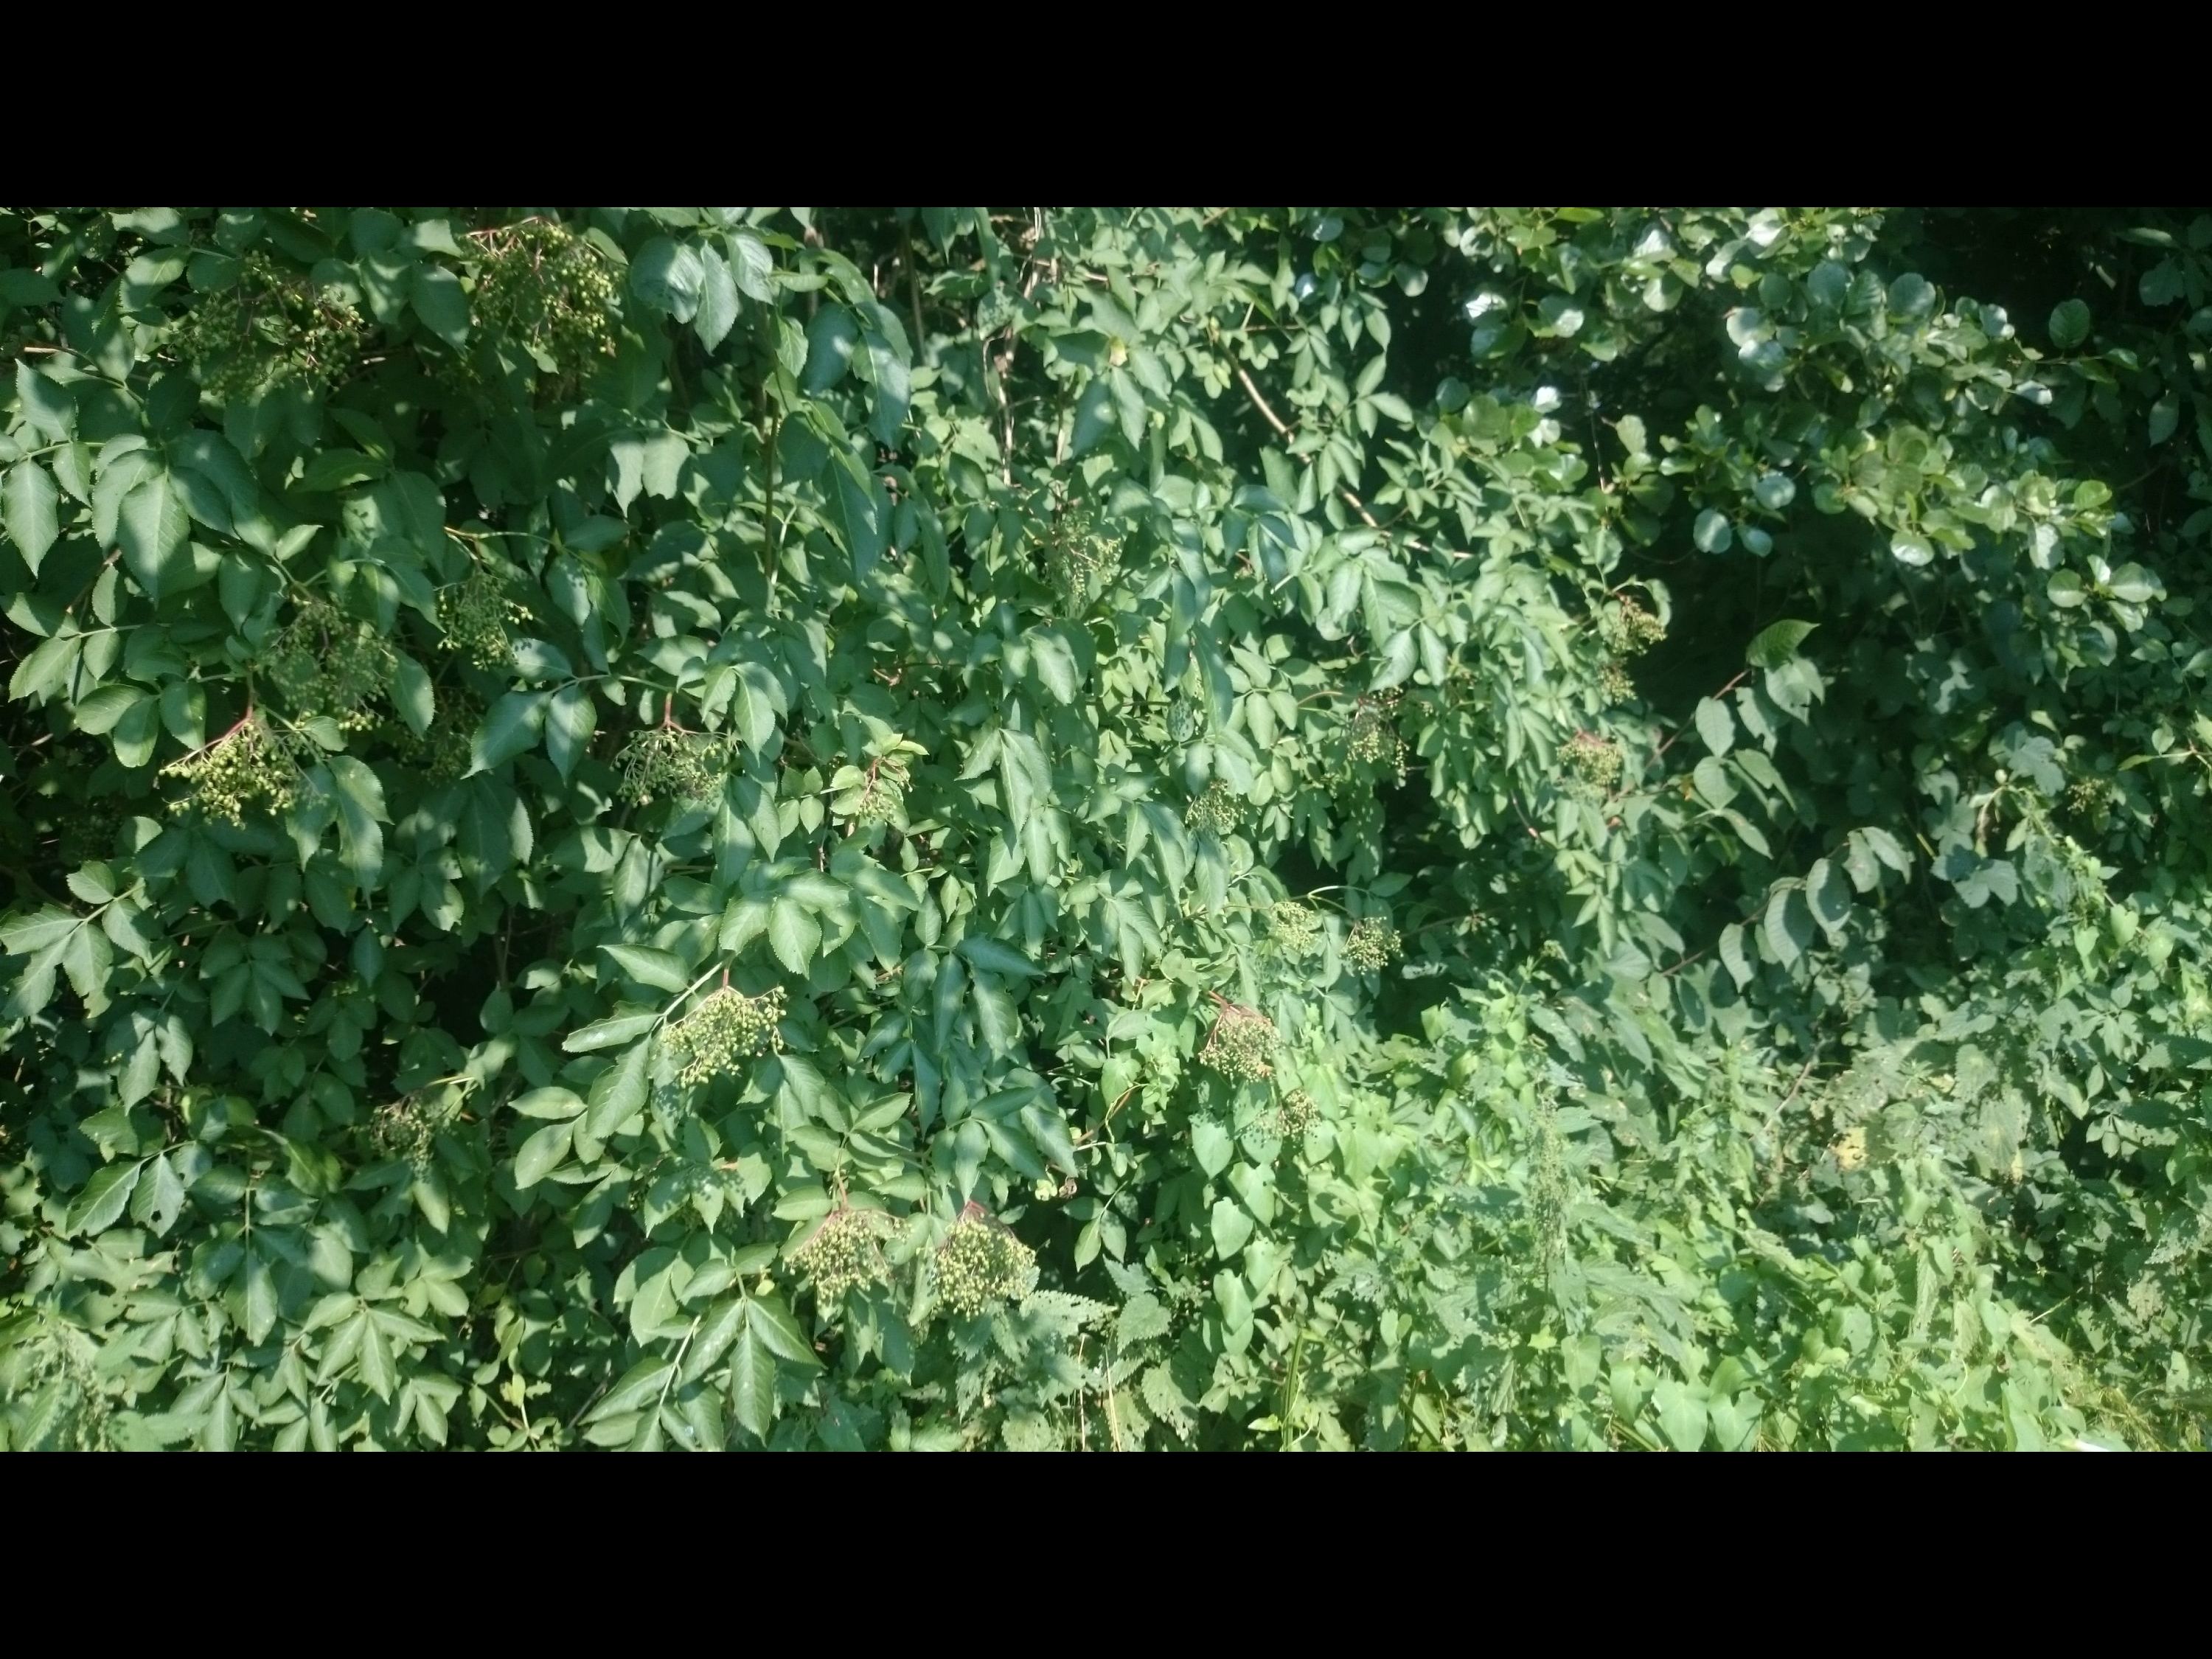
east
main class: Cropland
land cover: Soya
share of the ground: > 75 %
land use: Agriculture (excluding fallow land and kitchen gardens)
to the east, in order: Soya; Broadleaved woodland; Rivers and streams; Broadleaved woodland; Tracks; Broadleaved woodland; Spruce dominated coniferous woodland; Tracks; Pine dominated mixed woodland
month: July
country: AT
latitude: 47.0514
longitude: 15.9642
